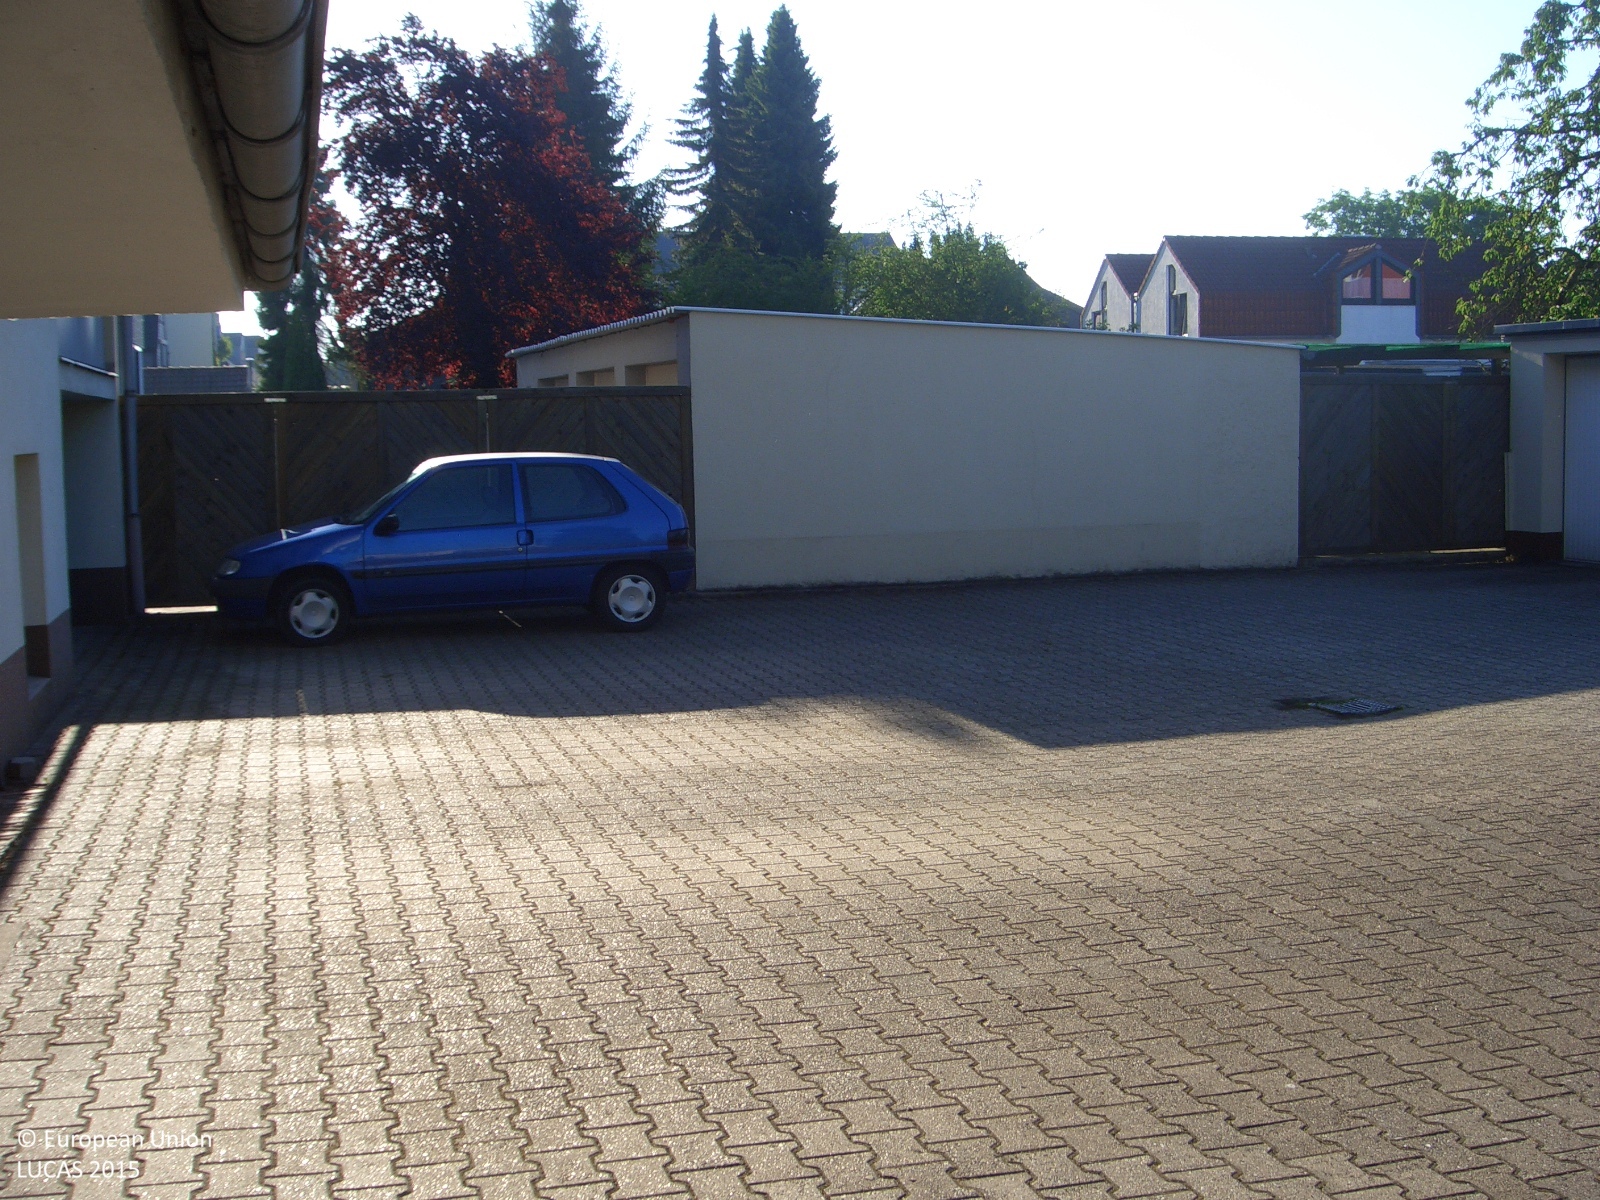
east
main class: Grassland
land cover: Grassland with sparse tree/shrub cover
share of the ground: > 75 %
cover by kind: herbaceous plants 95 %, broadleaved forest trees 5 %
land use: Residential
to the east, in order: Grassland with sparse tree/shrub cover; Artificial constructions in urban areas
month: June
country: DE
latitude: 51.0636
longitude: 7.0463
